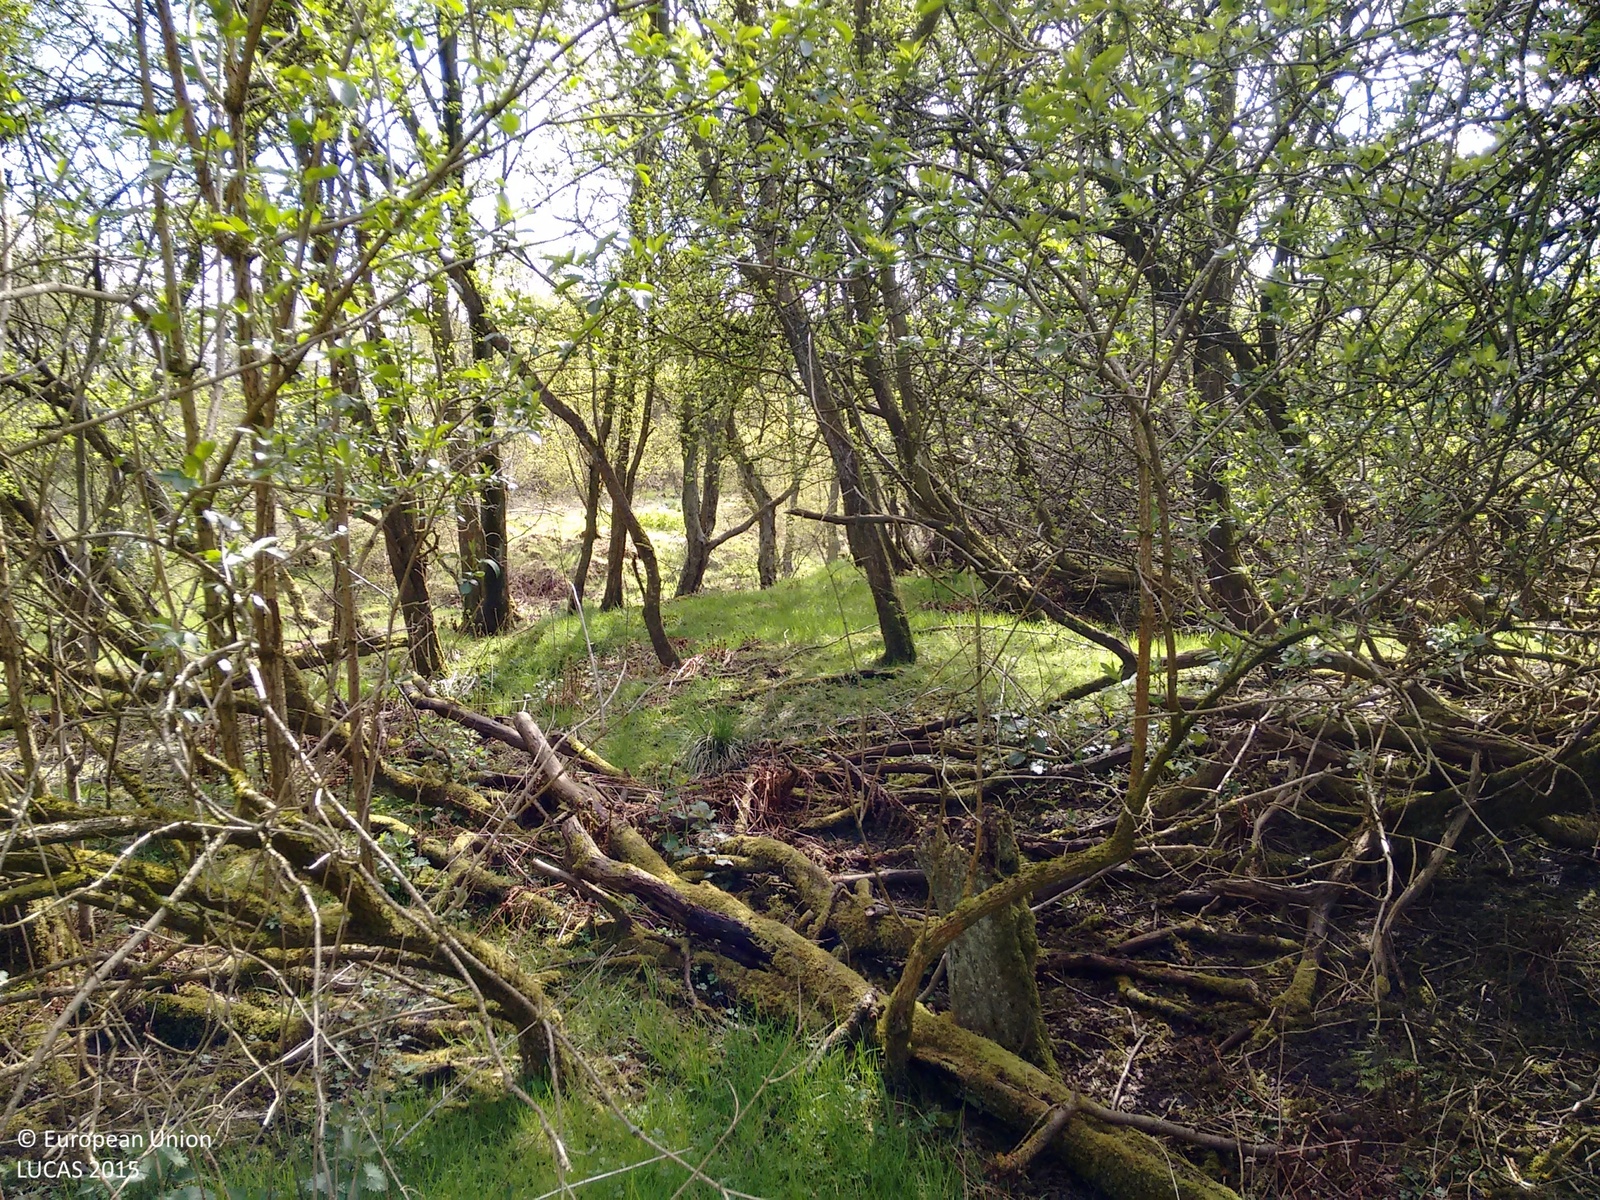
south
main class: Woodland
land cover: Broadleaved woodland
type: exotic forest
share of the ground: > 75 %
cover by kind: broadleaved forest trees 90 %, herbaceous plants 10 %
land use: Semi-natural and natural areas not in use
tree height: > 5 m
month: May
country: GB
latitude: 55.8922
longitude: -3.9828
